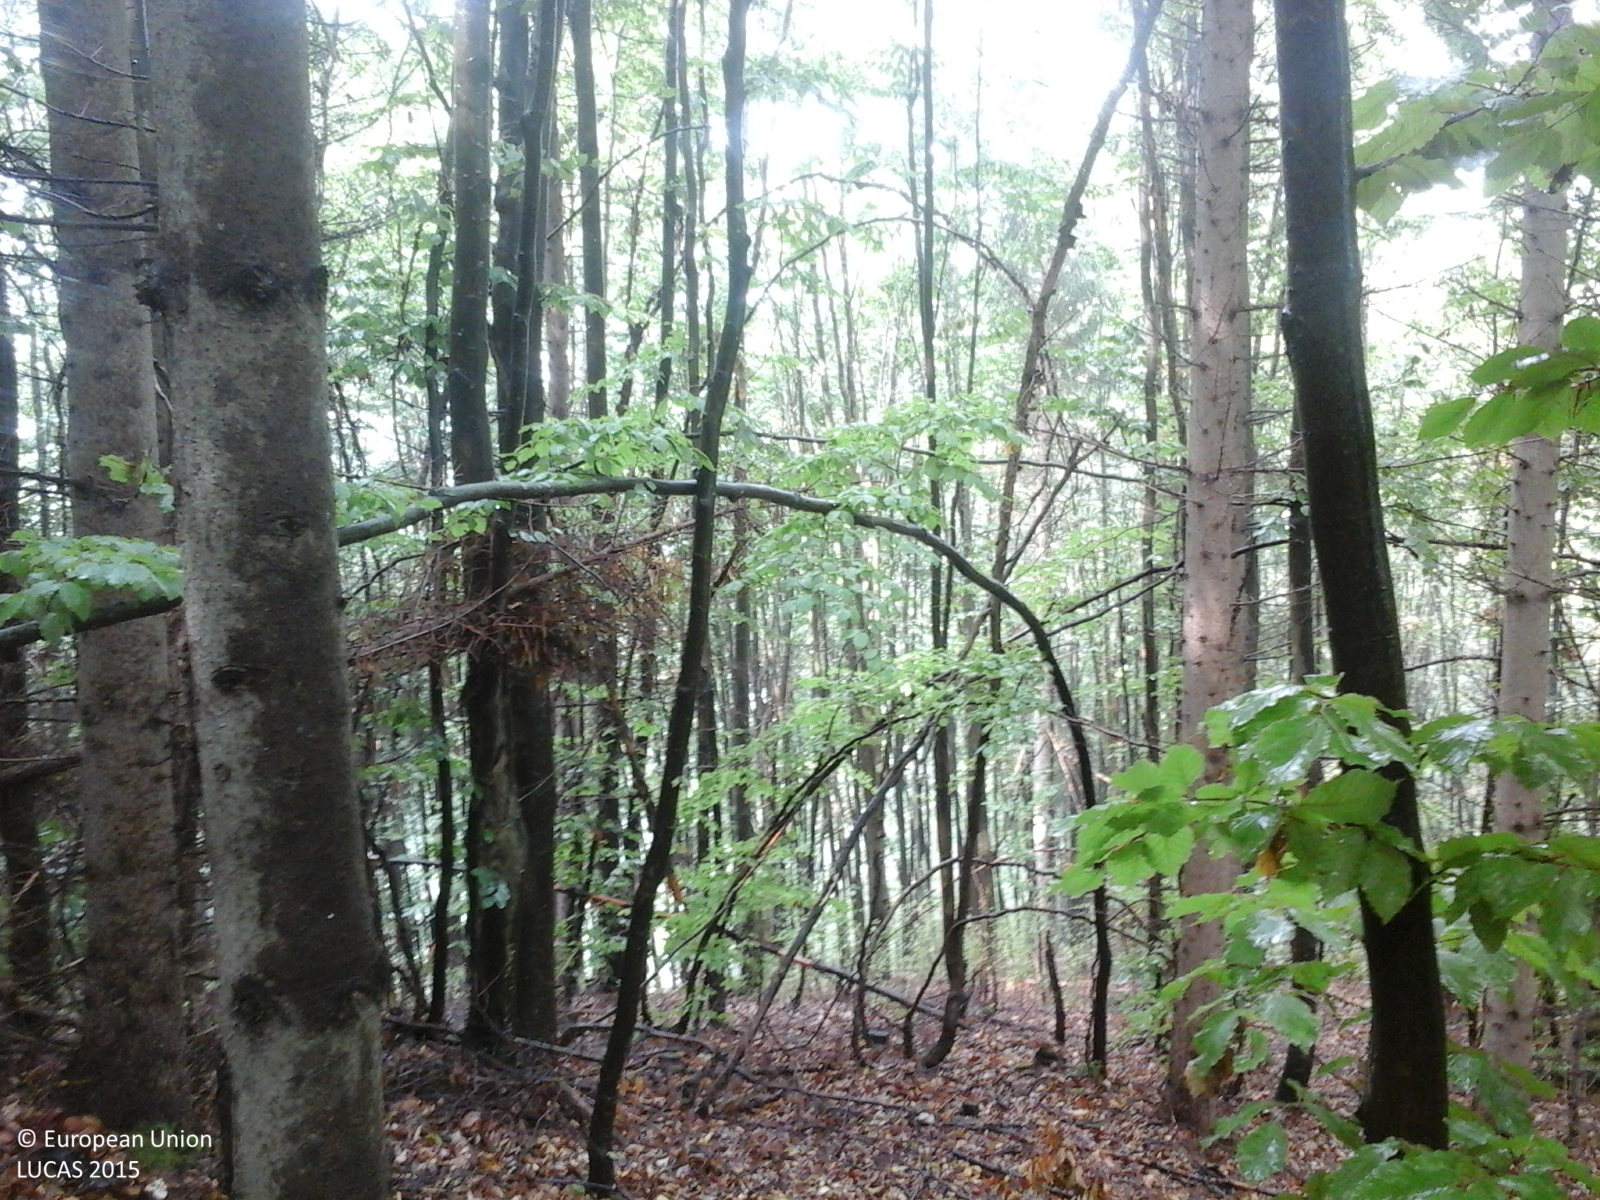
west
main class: Woodland
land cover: Other mixed woodland
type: mountainous beech forest
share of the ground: > 75 %
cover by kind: broadleaved forest trees 75 %, coniferous forest trees 25 %
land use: Forestry
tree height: > 5 m
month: September
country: RO
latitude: 47.5940
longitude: 24.0350
